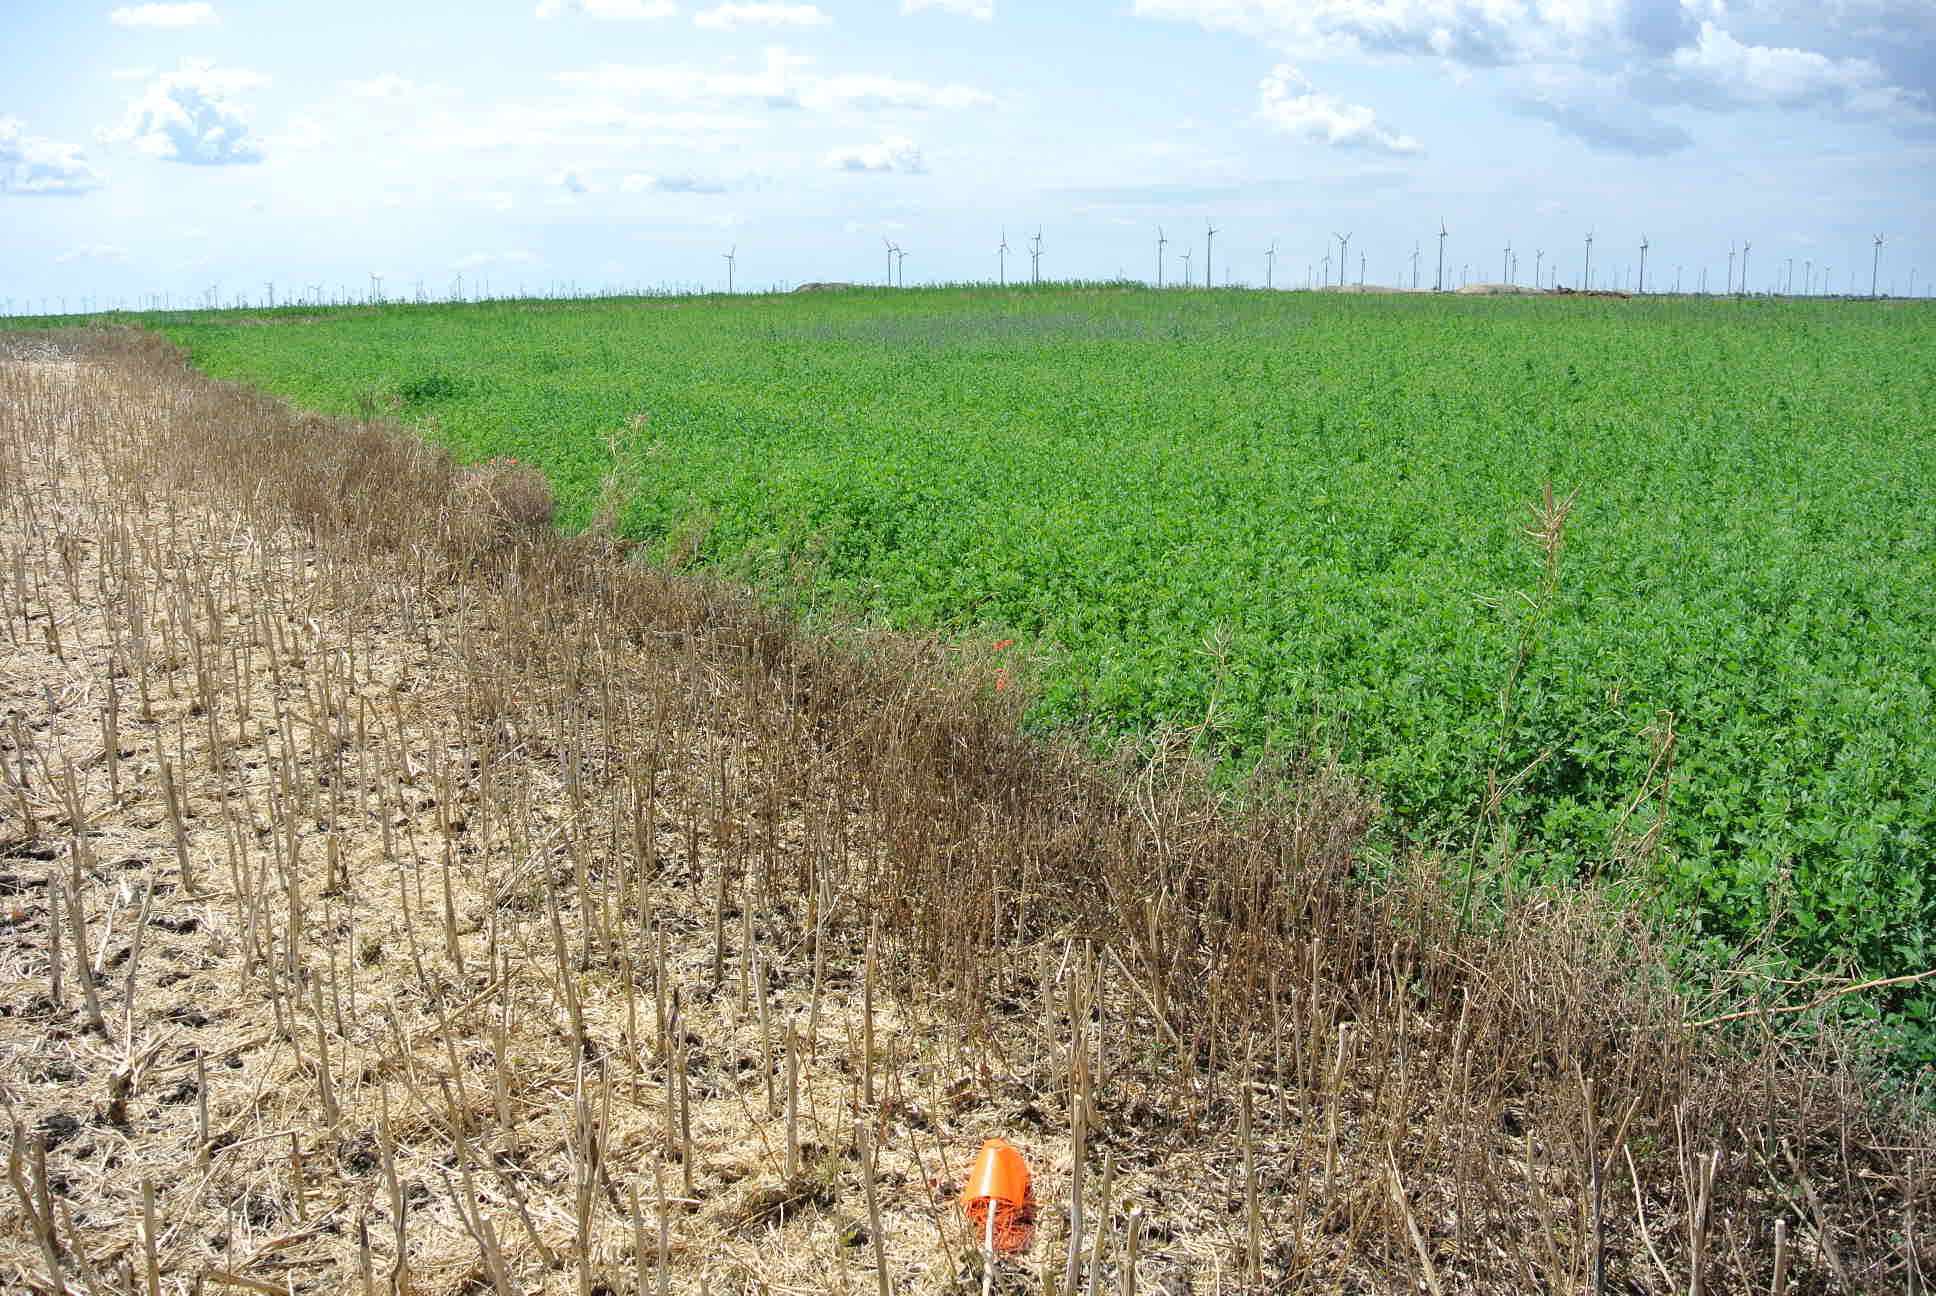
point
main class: Cropland
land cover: Rape and turnip rape
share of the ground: > 75 %
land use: Agriculture (excluding fallow land and kitchen gardens)
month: July
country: AT
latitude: 48.0067
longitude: 16.9099
